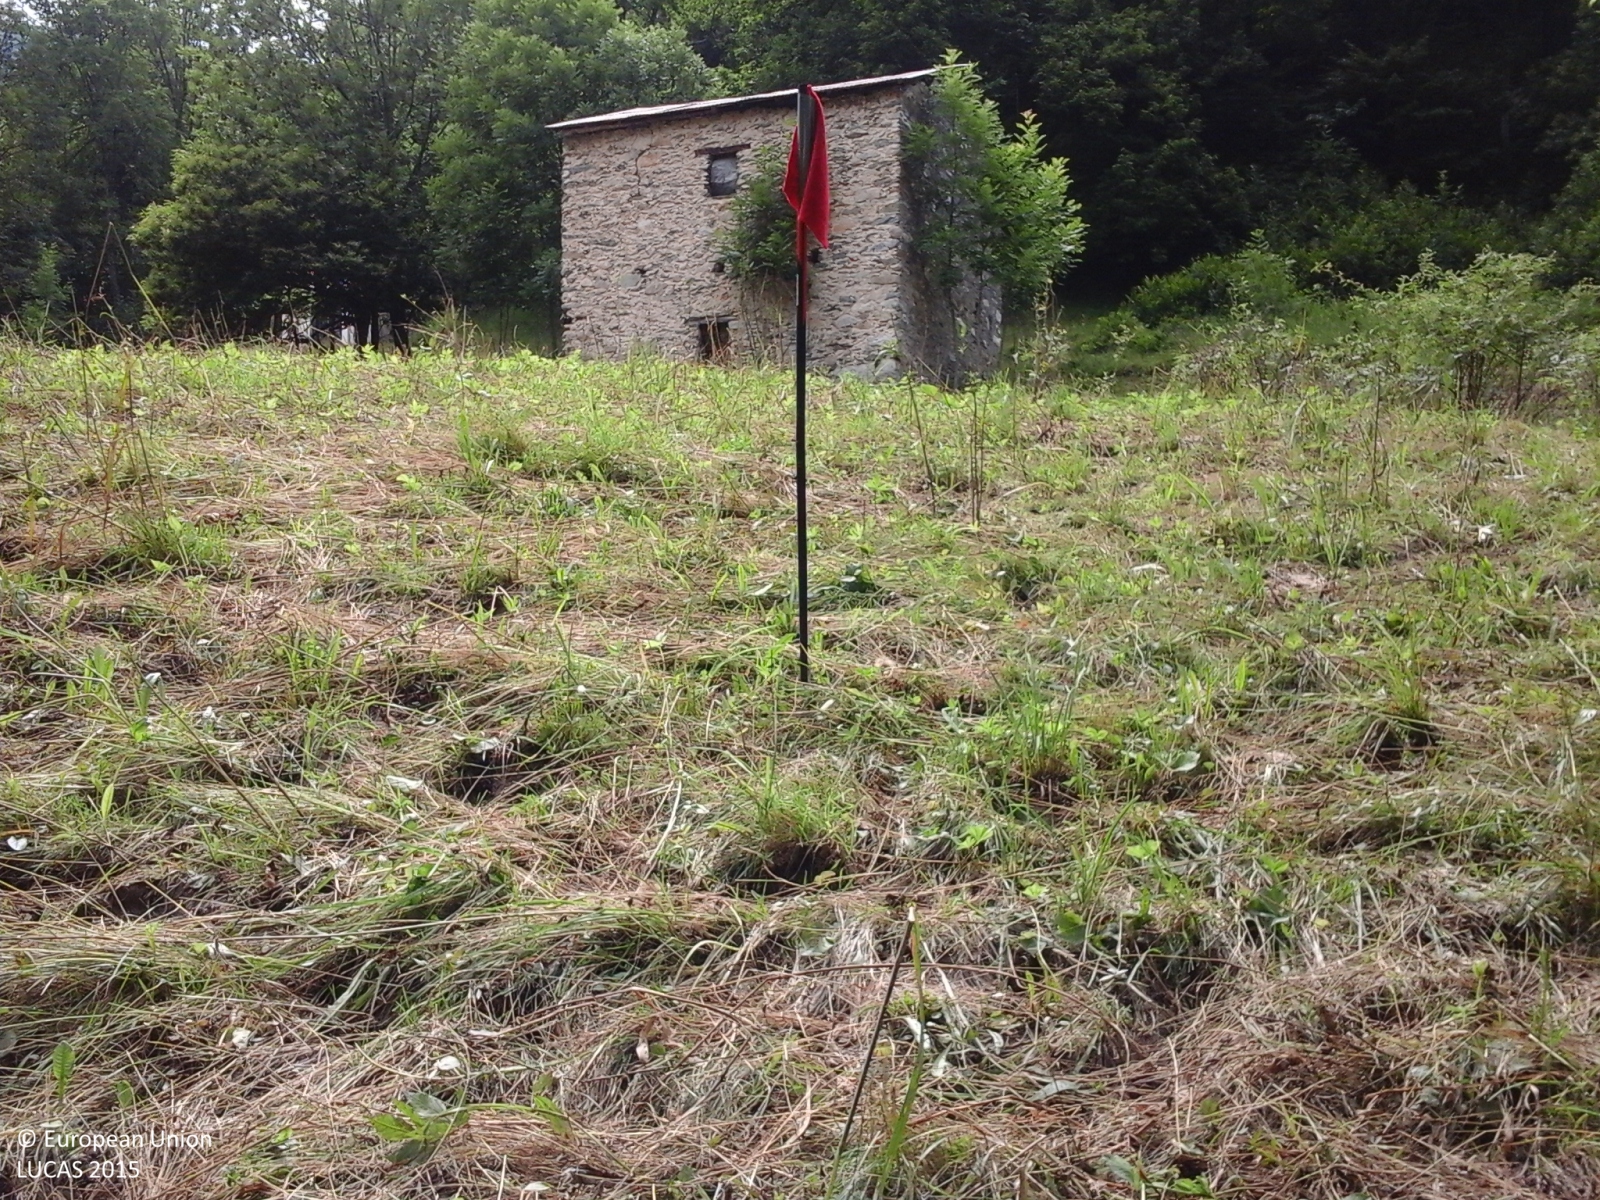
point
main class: Grassland
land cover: Grassland without tree/shrub cover
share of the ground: > 75 %
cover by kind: herbaceous plants 100 %
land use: Agriculture (excluding fallow land and kitchen gardens)
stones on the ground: < 10 %
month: June
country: IT
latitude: 44.2379
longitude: 7.8387
